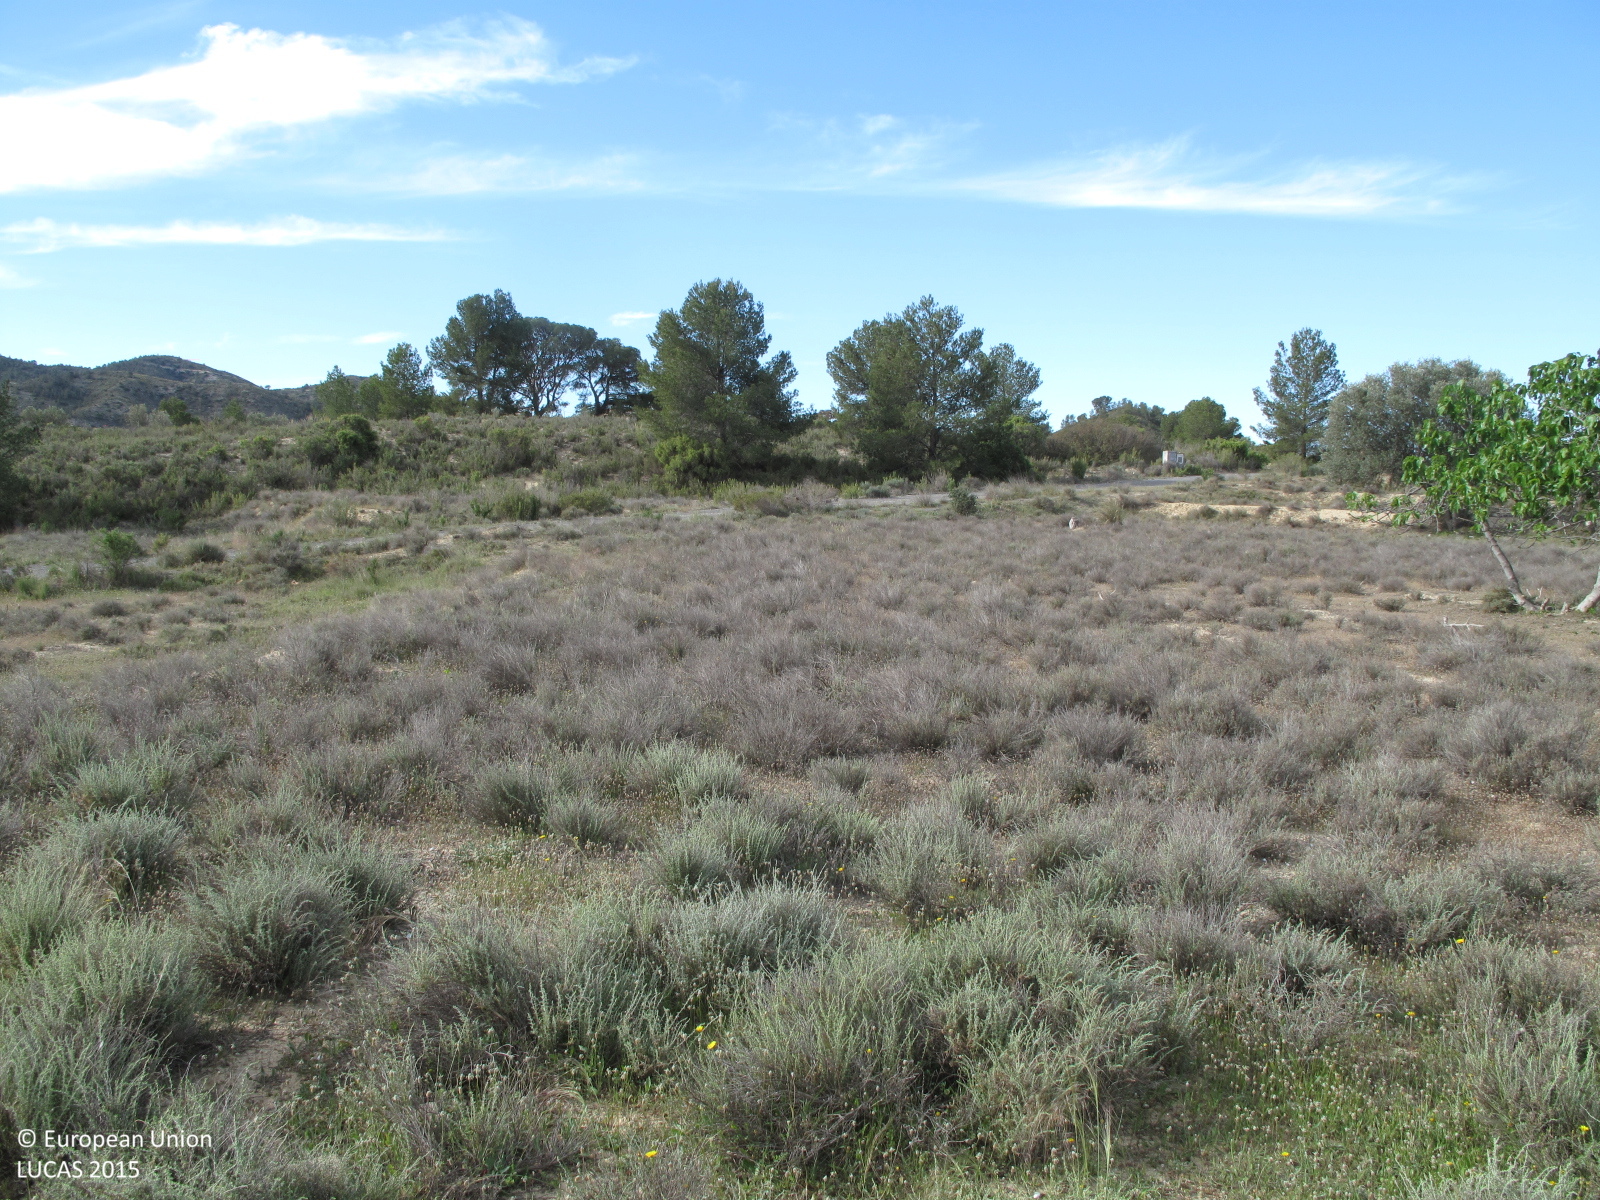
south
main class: Shrubland
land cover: Shrubland without tree cover
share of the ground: 50 - 75 %
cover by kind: shrubs 60 %, herbaceous plants 25 %, consolidated bare surface 15 %
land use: Abandoned areas
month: April
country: ES
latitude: 38.5543
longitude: -0.4874
